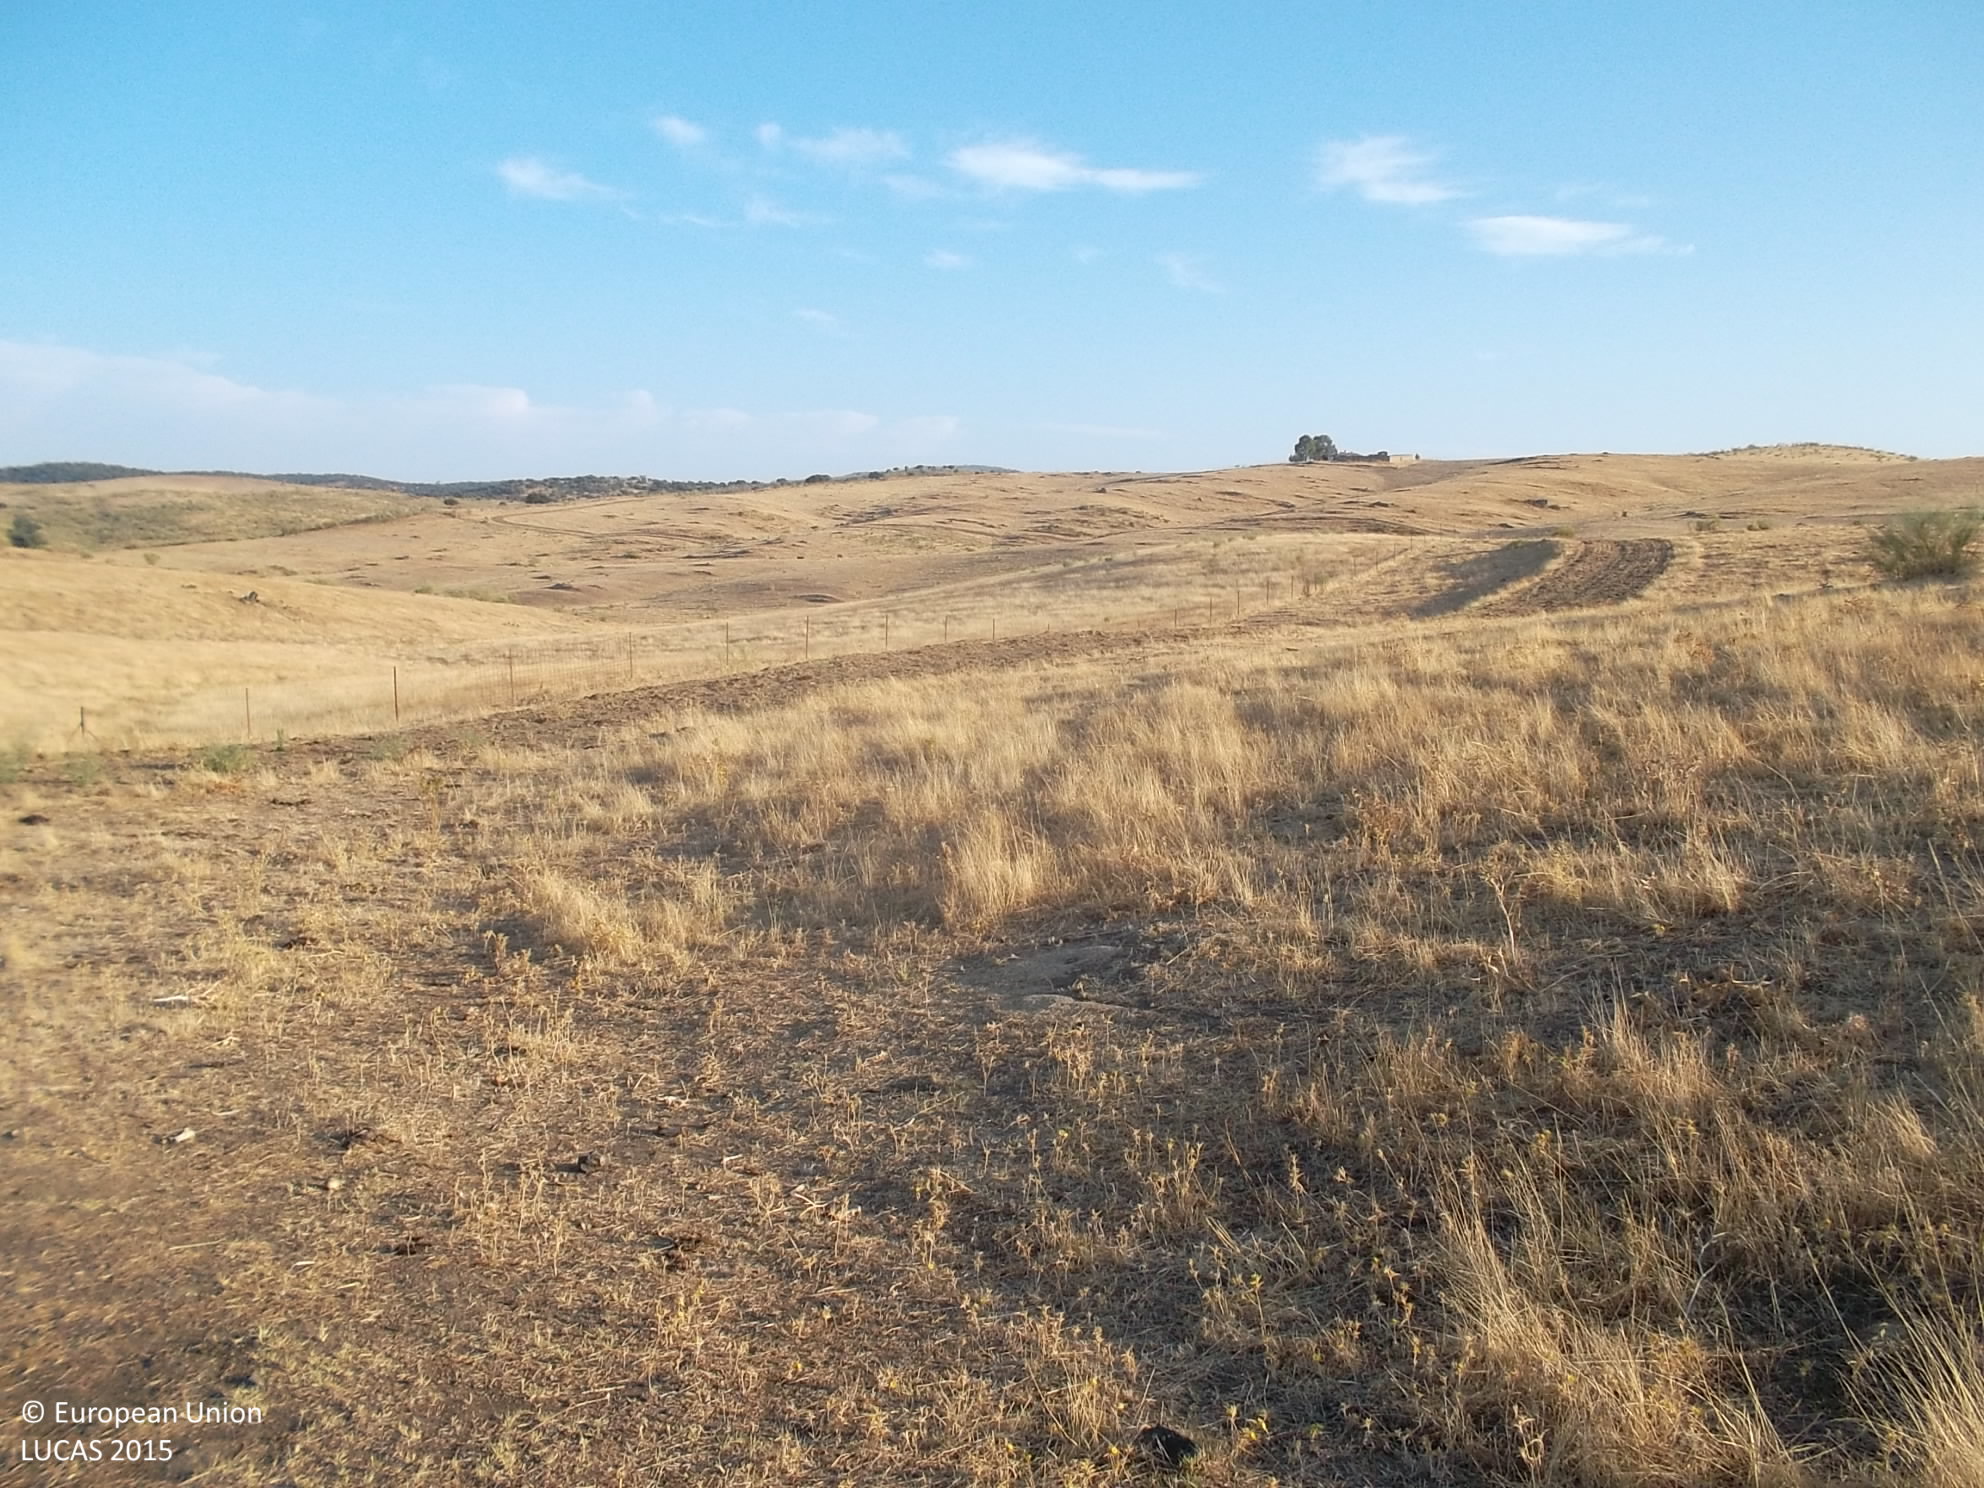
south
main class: Grassland
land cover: Grassland without tree/shrub cover
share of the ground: > 75 %
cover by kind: herbaceous plants 100 %
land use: Agriculture (excluding fallow land and kitchen gardens)
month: September
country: ES
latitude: 38.1558
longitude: -6.3058
